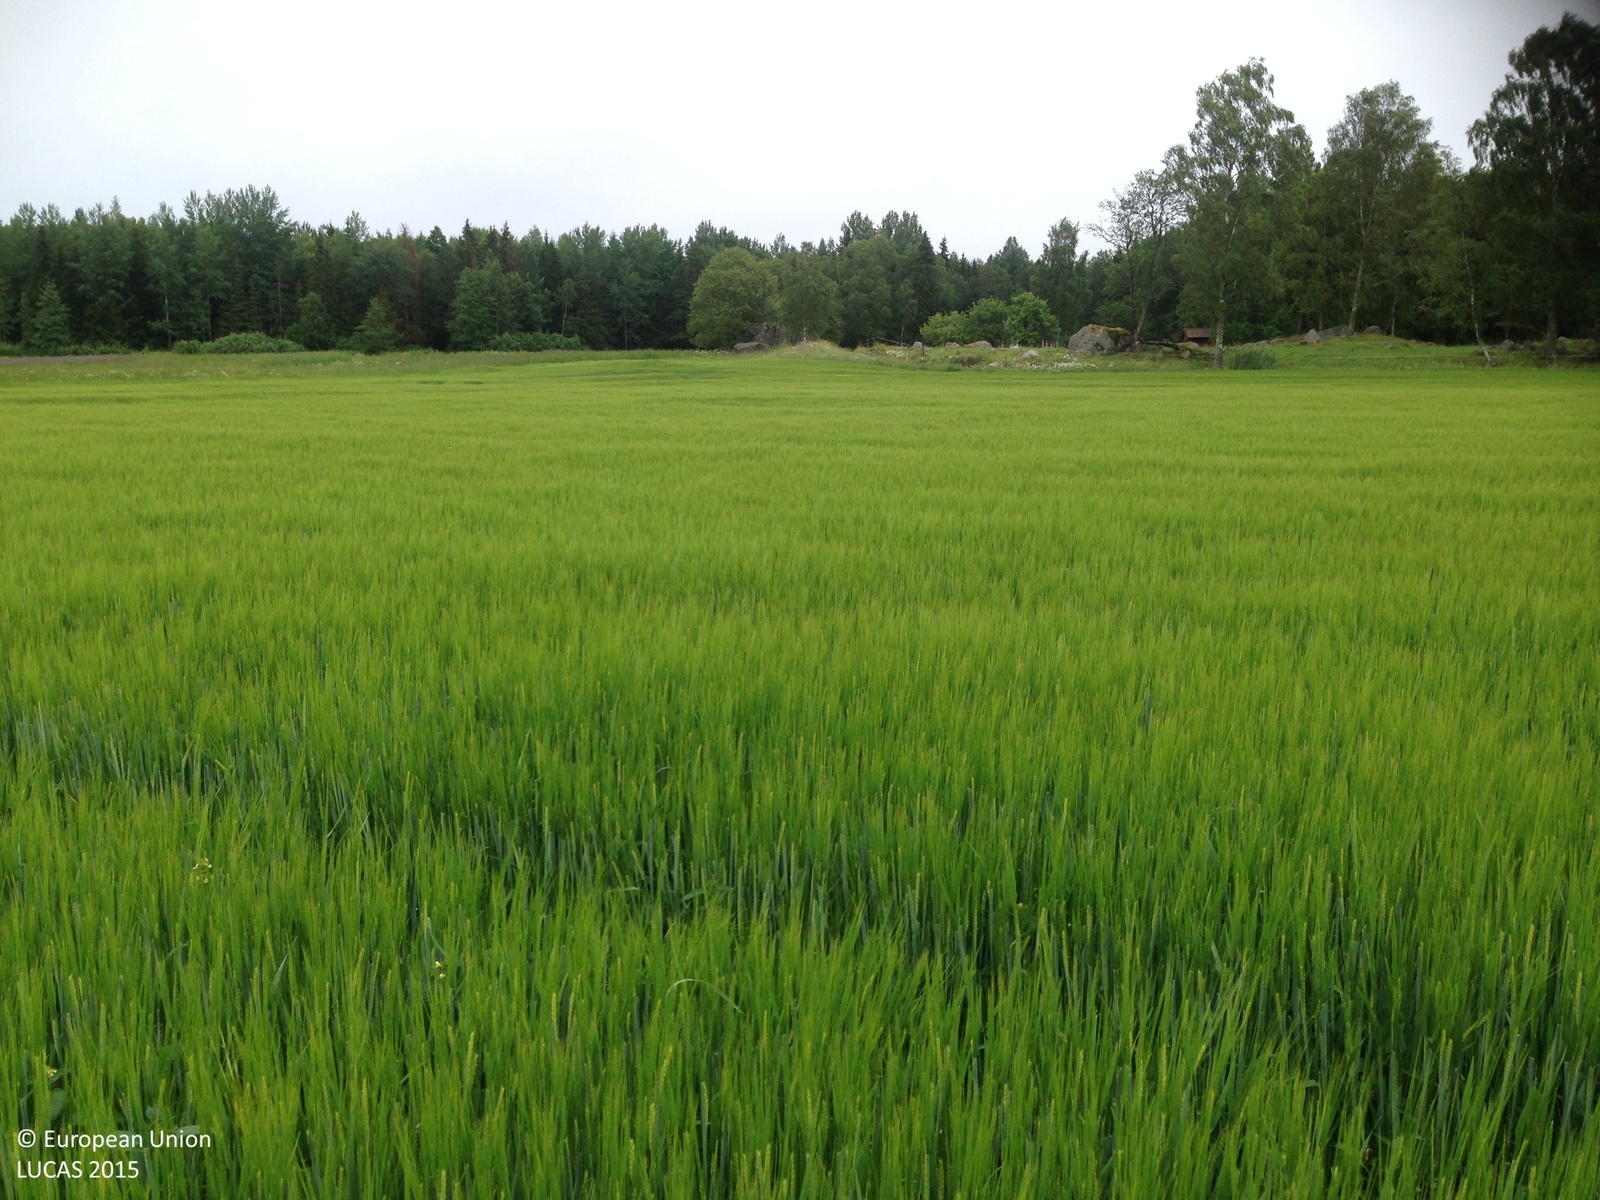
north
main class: Cropland
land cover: Barley
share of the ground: > 75 %
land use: Agriculture (excluding fallow land and kitchen gardens)
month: July
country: SE
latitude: 59.9010
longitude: 16.9460
